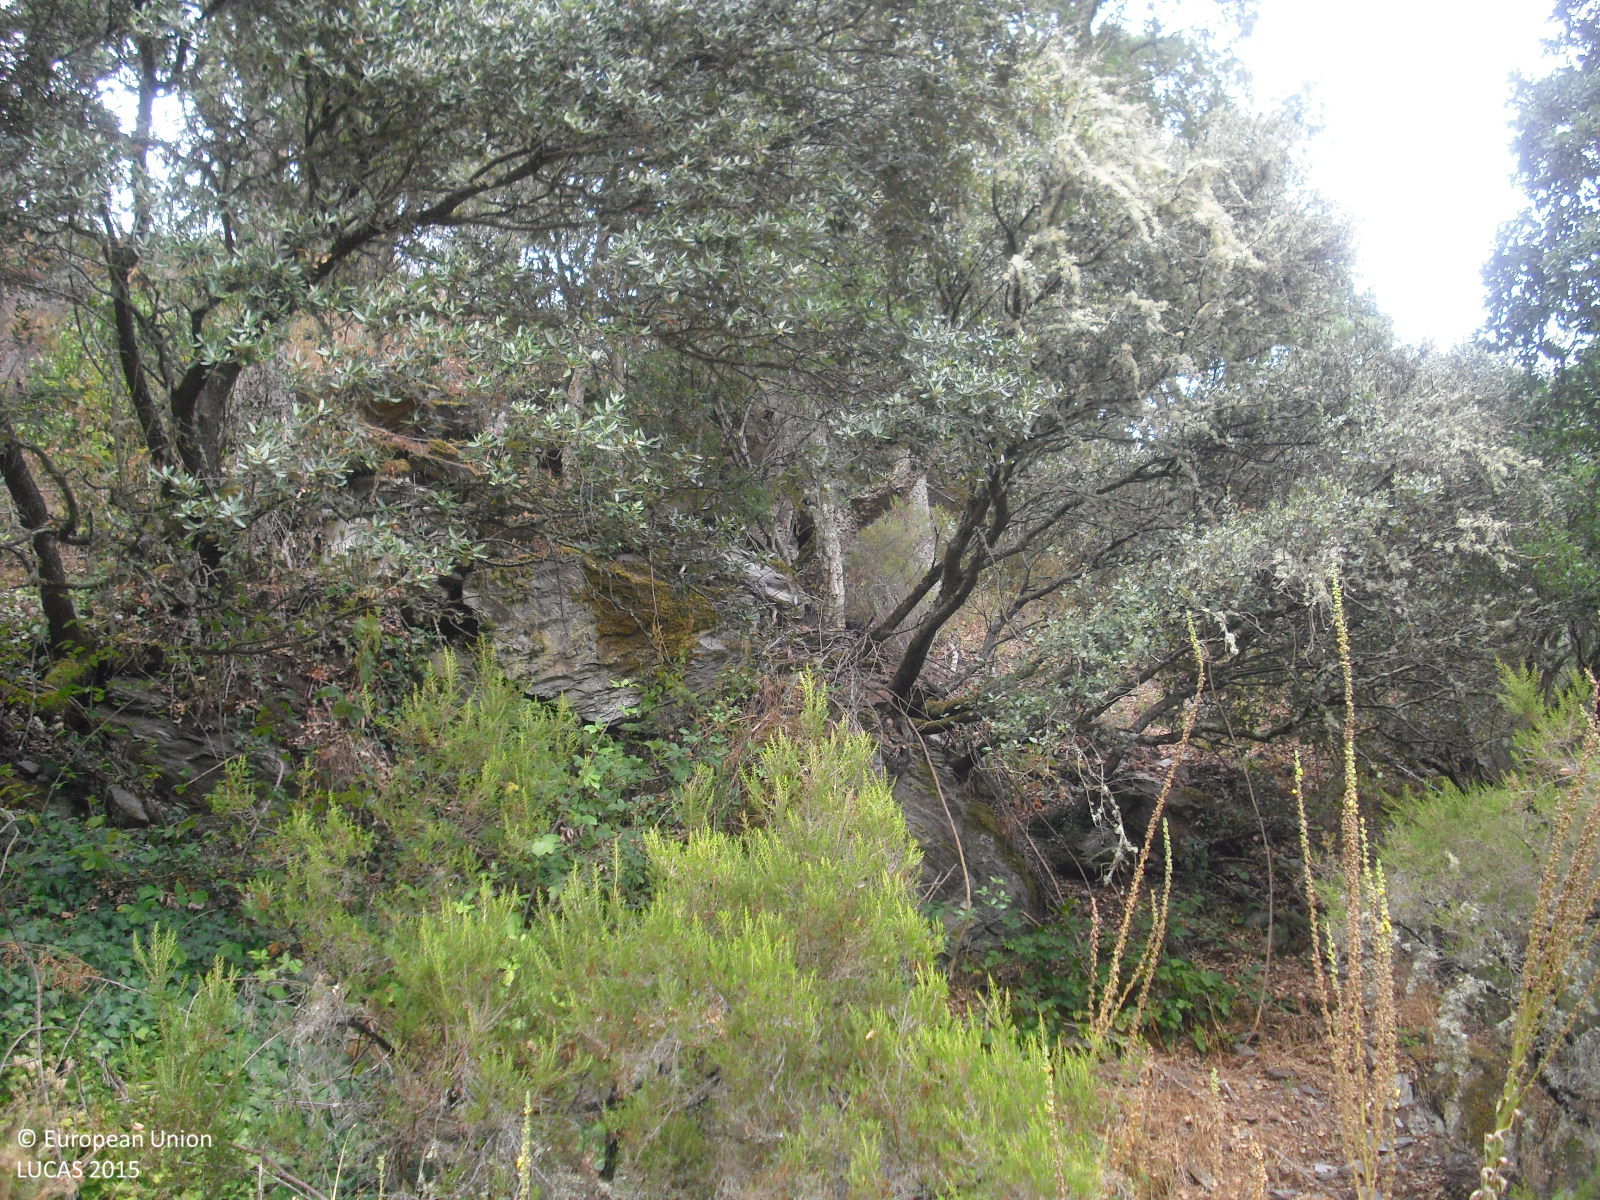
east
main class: Woodland
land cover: Broadleaved woodland
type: thermophilous deciduous forest
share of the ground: > 75 %
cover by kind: broadleaved forest trees 70 %, shrubs 30 %
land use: Semi-natural and natural areas not in use
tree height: > 5 m
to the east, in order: Broadleaved woodland; Rivers and streams; Broadleaved woodland; Paved roads, cycling and walking lanes; Ditches and canals; Pine dominated mixed woodland; Shrubland without tree cover; Electric lines; Dry stone walls; Broadleaved woodland; Ditches and canals; Paved roads, cycling and walking lanes; Ditches and canals; Pine dominated mixed woodland
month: July
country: ES
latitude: 42.4559
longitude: -7.2188
